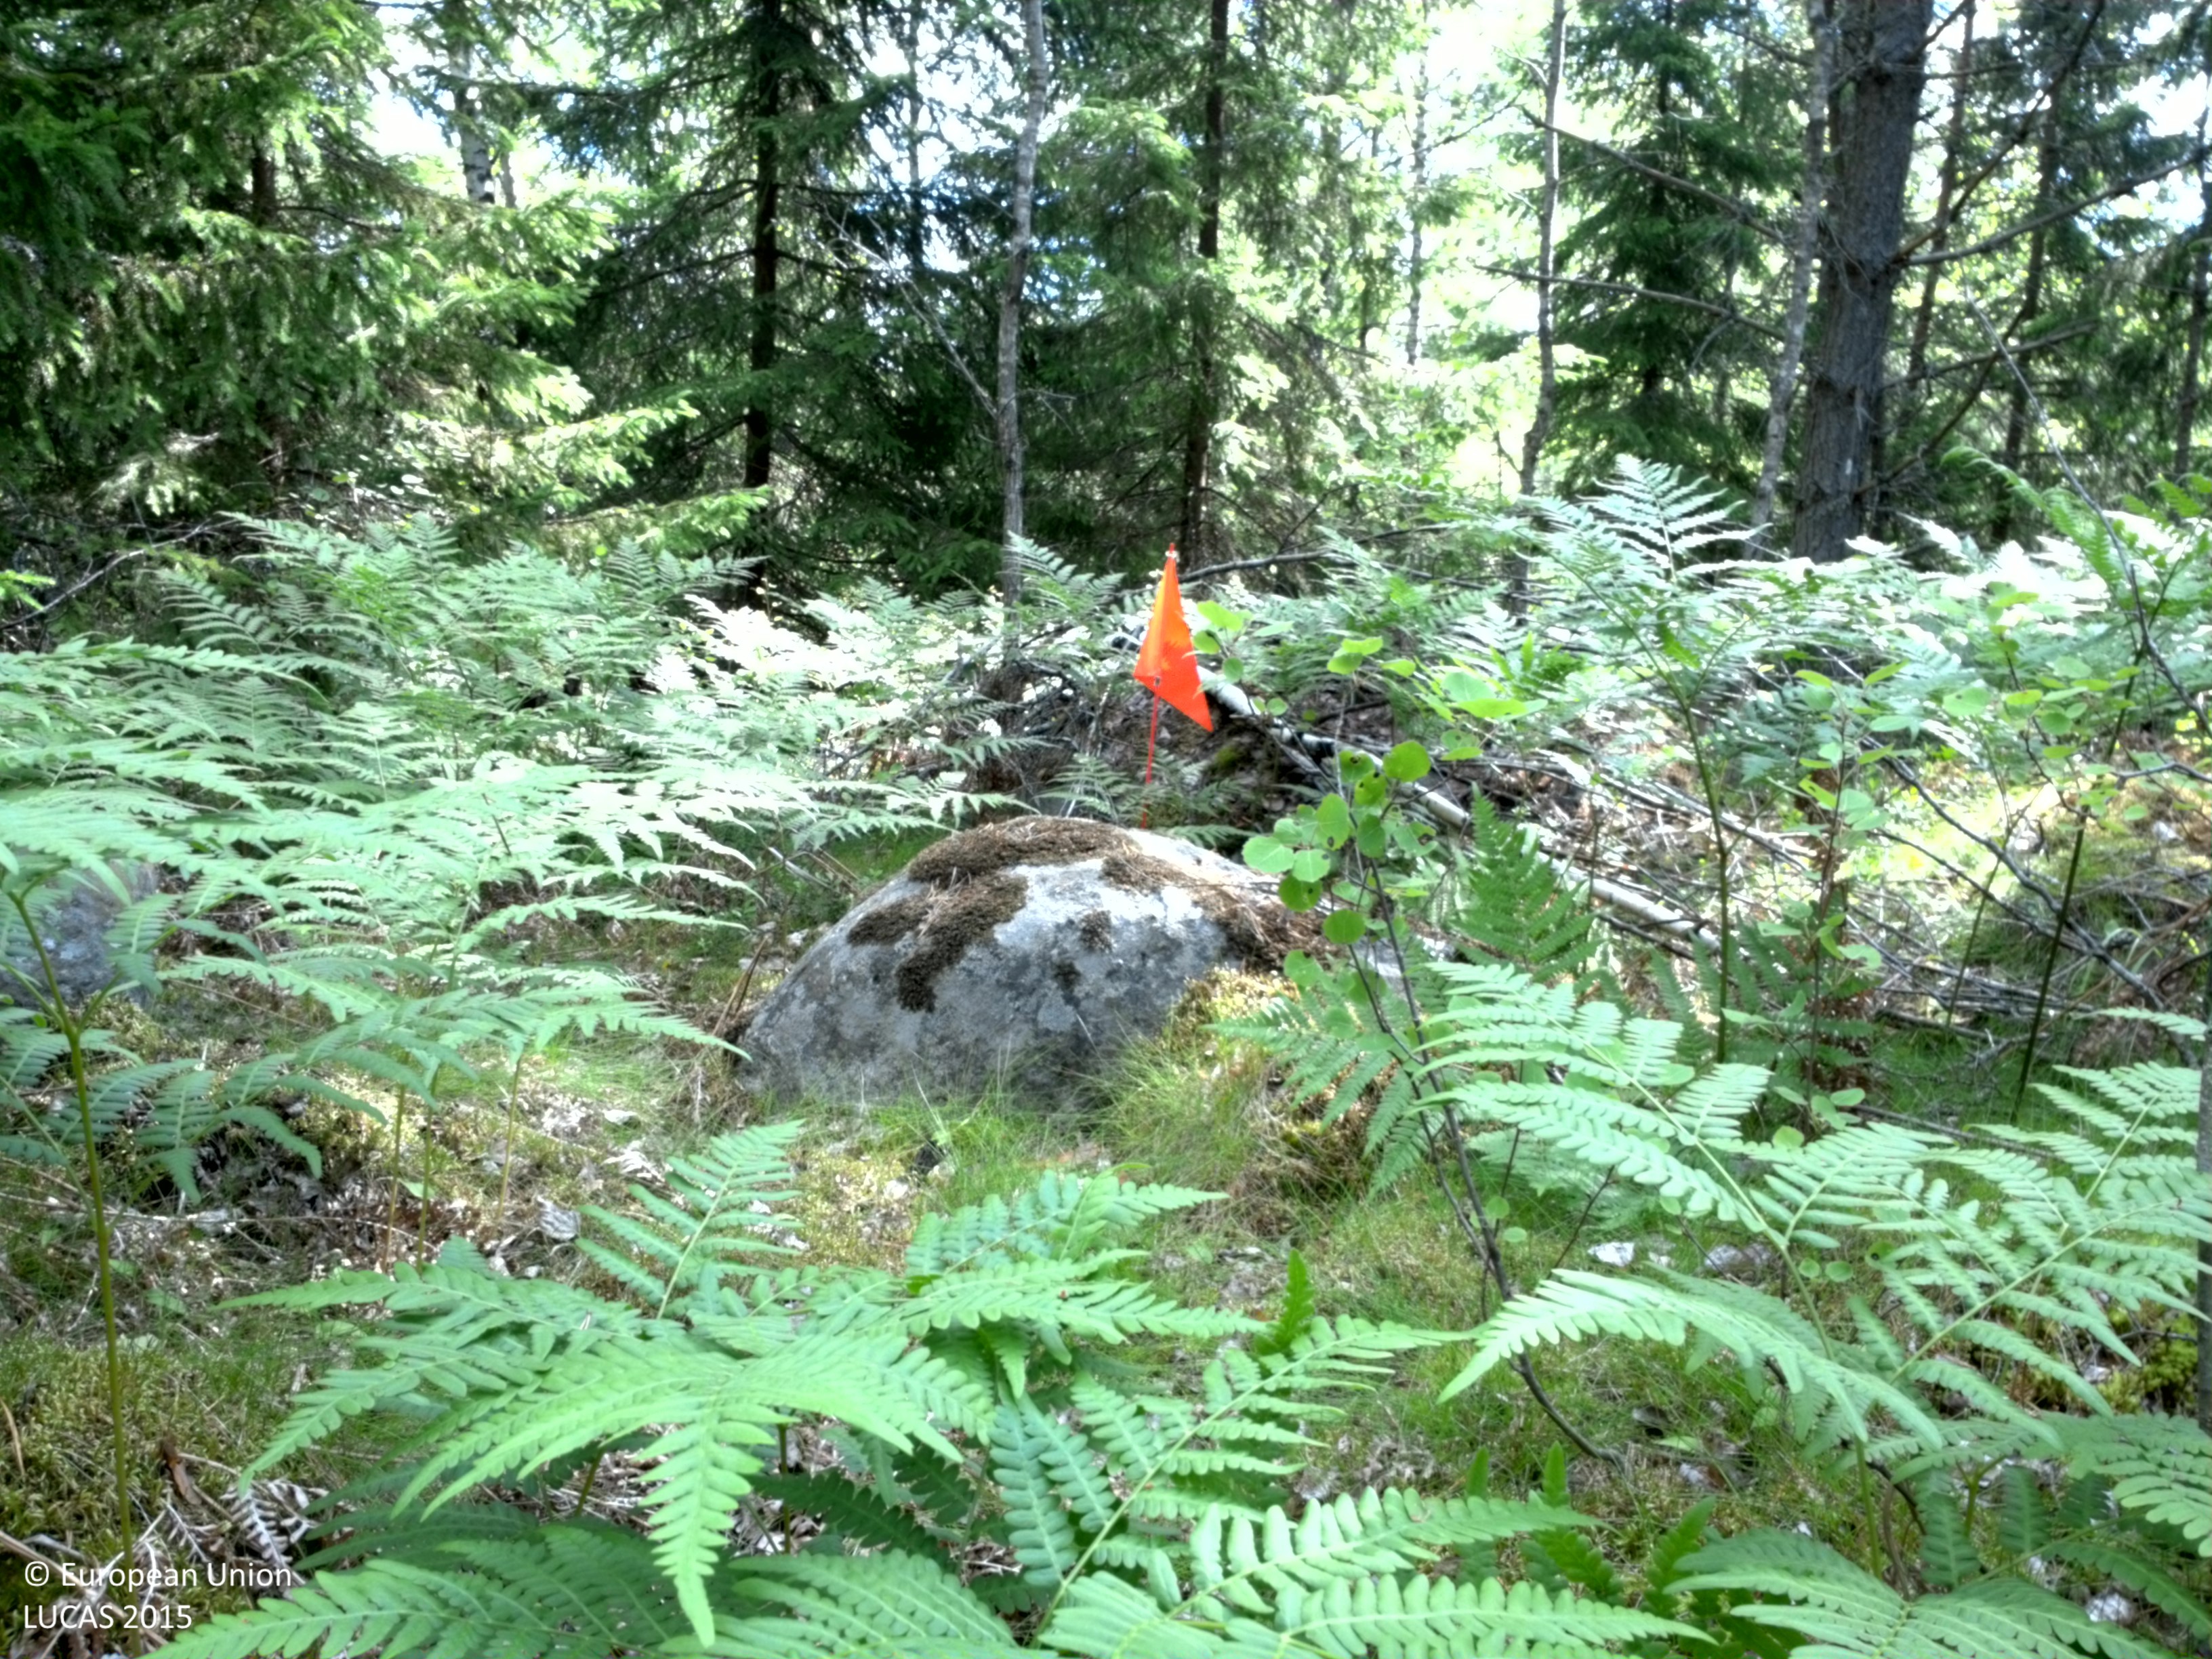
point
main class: Woodland
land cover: Spruce dominated mixed woodland
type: boreal forest
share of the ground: 50 - 75 %
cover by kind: coniferous forest trees 45 %, herbaceous plants 20 %, lichens and mosses 20 %, broadleaved forest trees 15 %
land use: Forestry
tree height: > 5 m
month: June
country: SE
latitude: 59.6272
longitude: 18.3144
